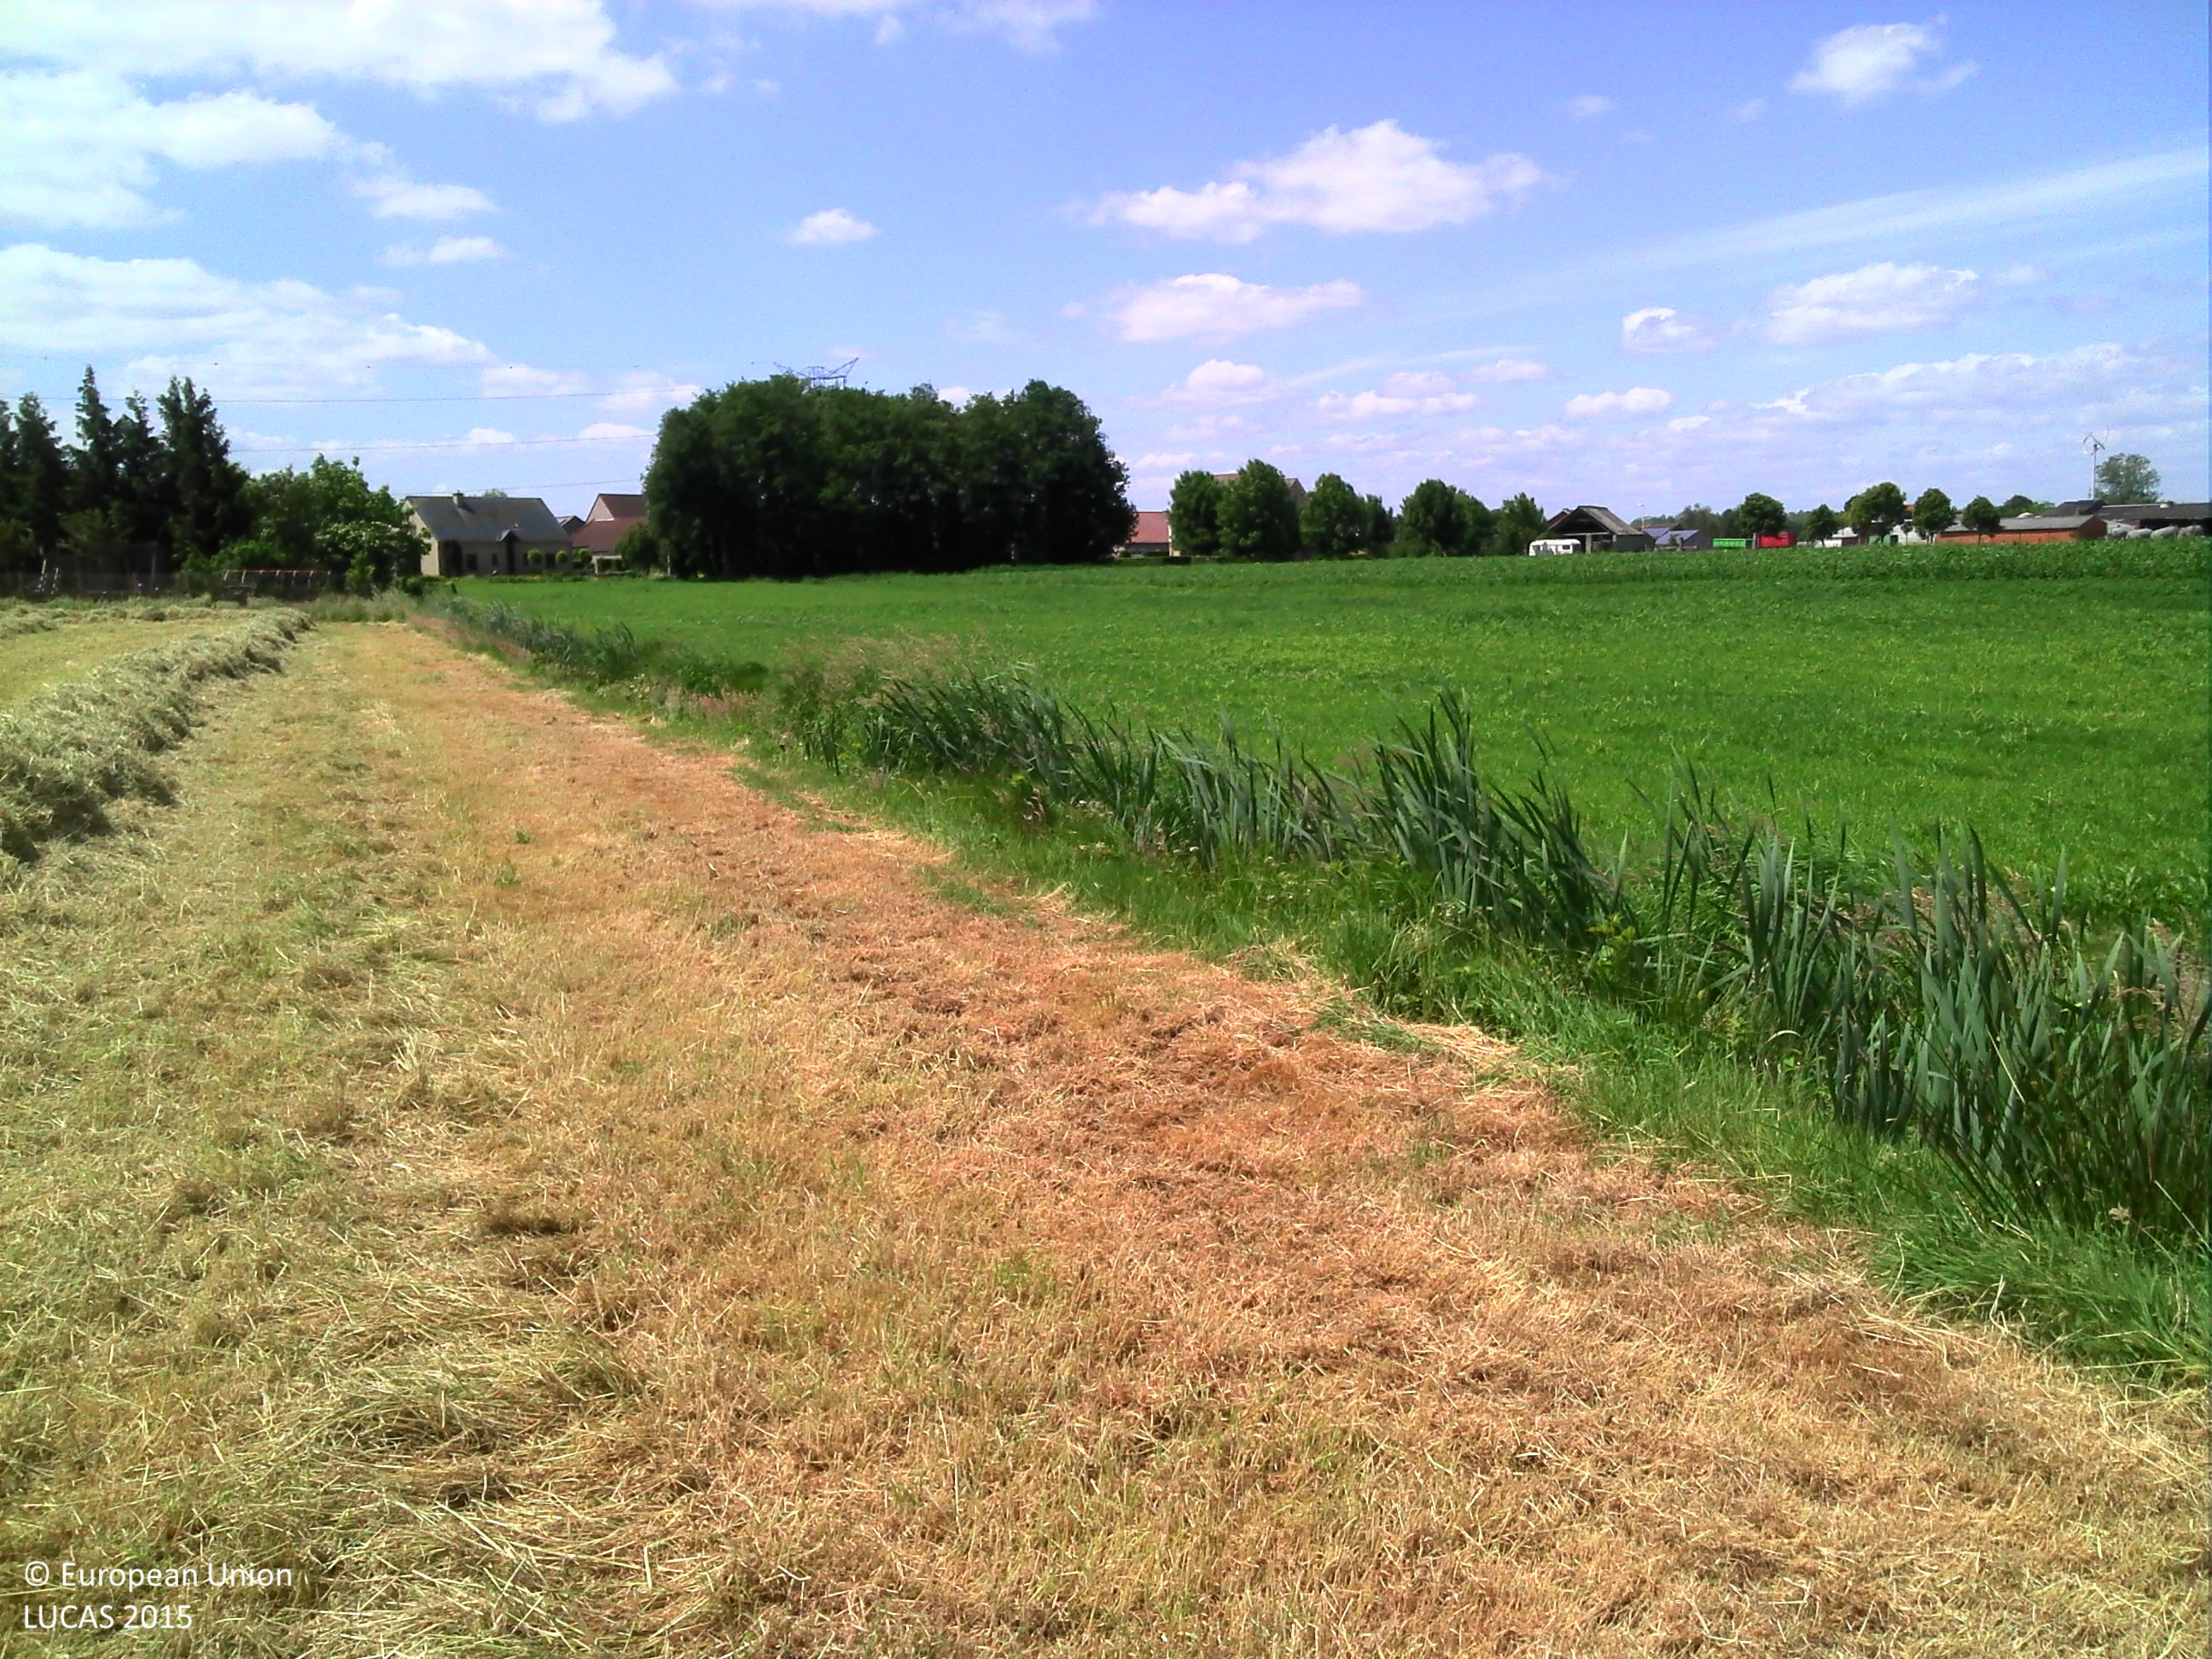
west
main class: Grassland
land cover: Grassland without tree/shrub cover
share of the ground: > 75 %
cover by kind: herbaceous plants 100 %
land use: Agriculture (excluding fallow land and kitchen gardens)
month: June
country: BE
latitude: 51.1484
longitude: 5.7242
